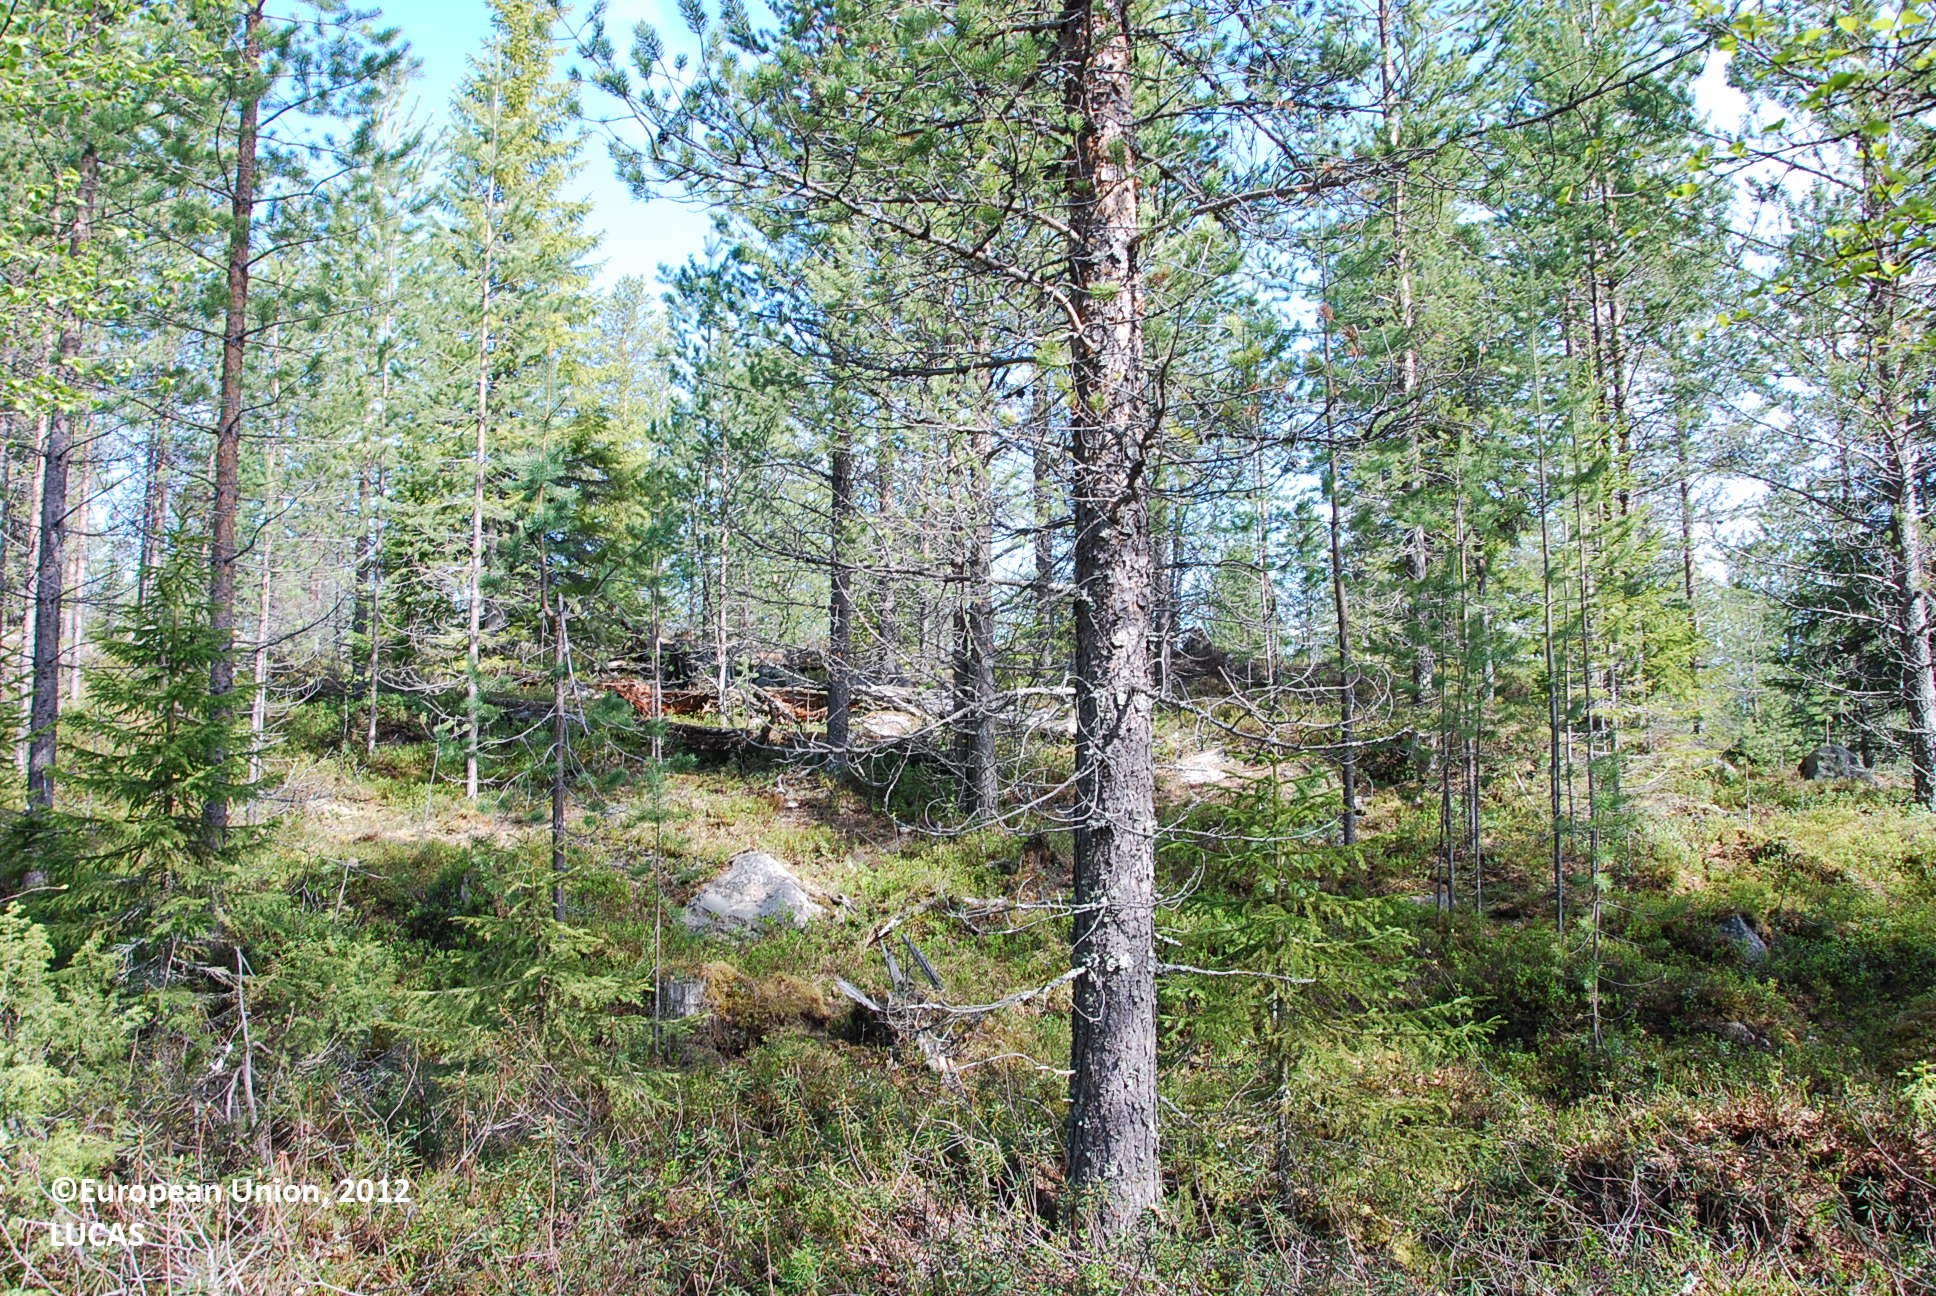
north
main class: Woodland
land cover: Other mixed woodland
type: boreal forest
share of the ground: > 75 %
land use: Forestry
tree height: > 5 m
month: June
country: FI
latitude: 66.3406
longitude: 27.8357
